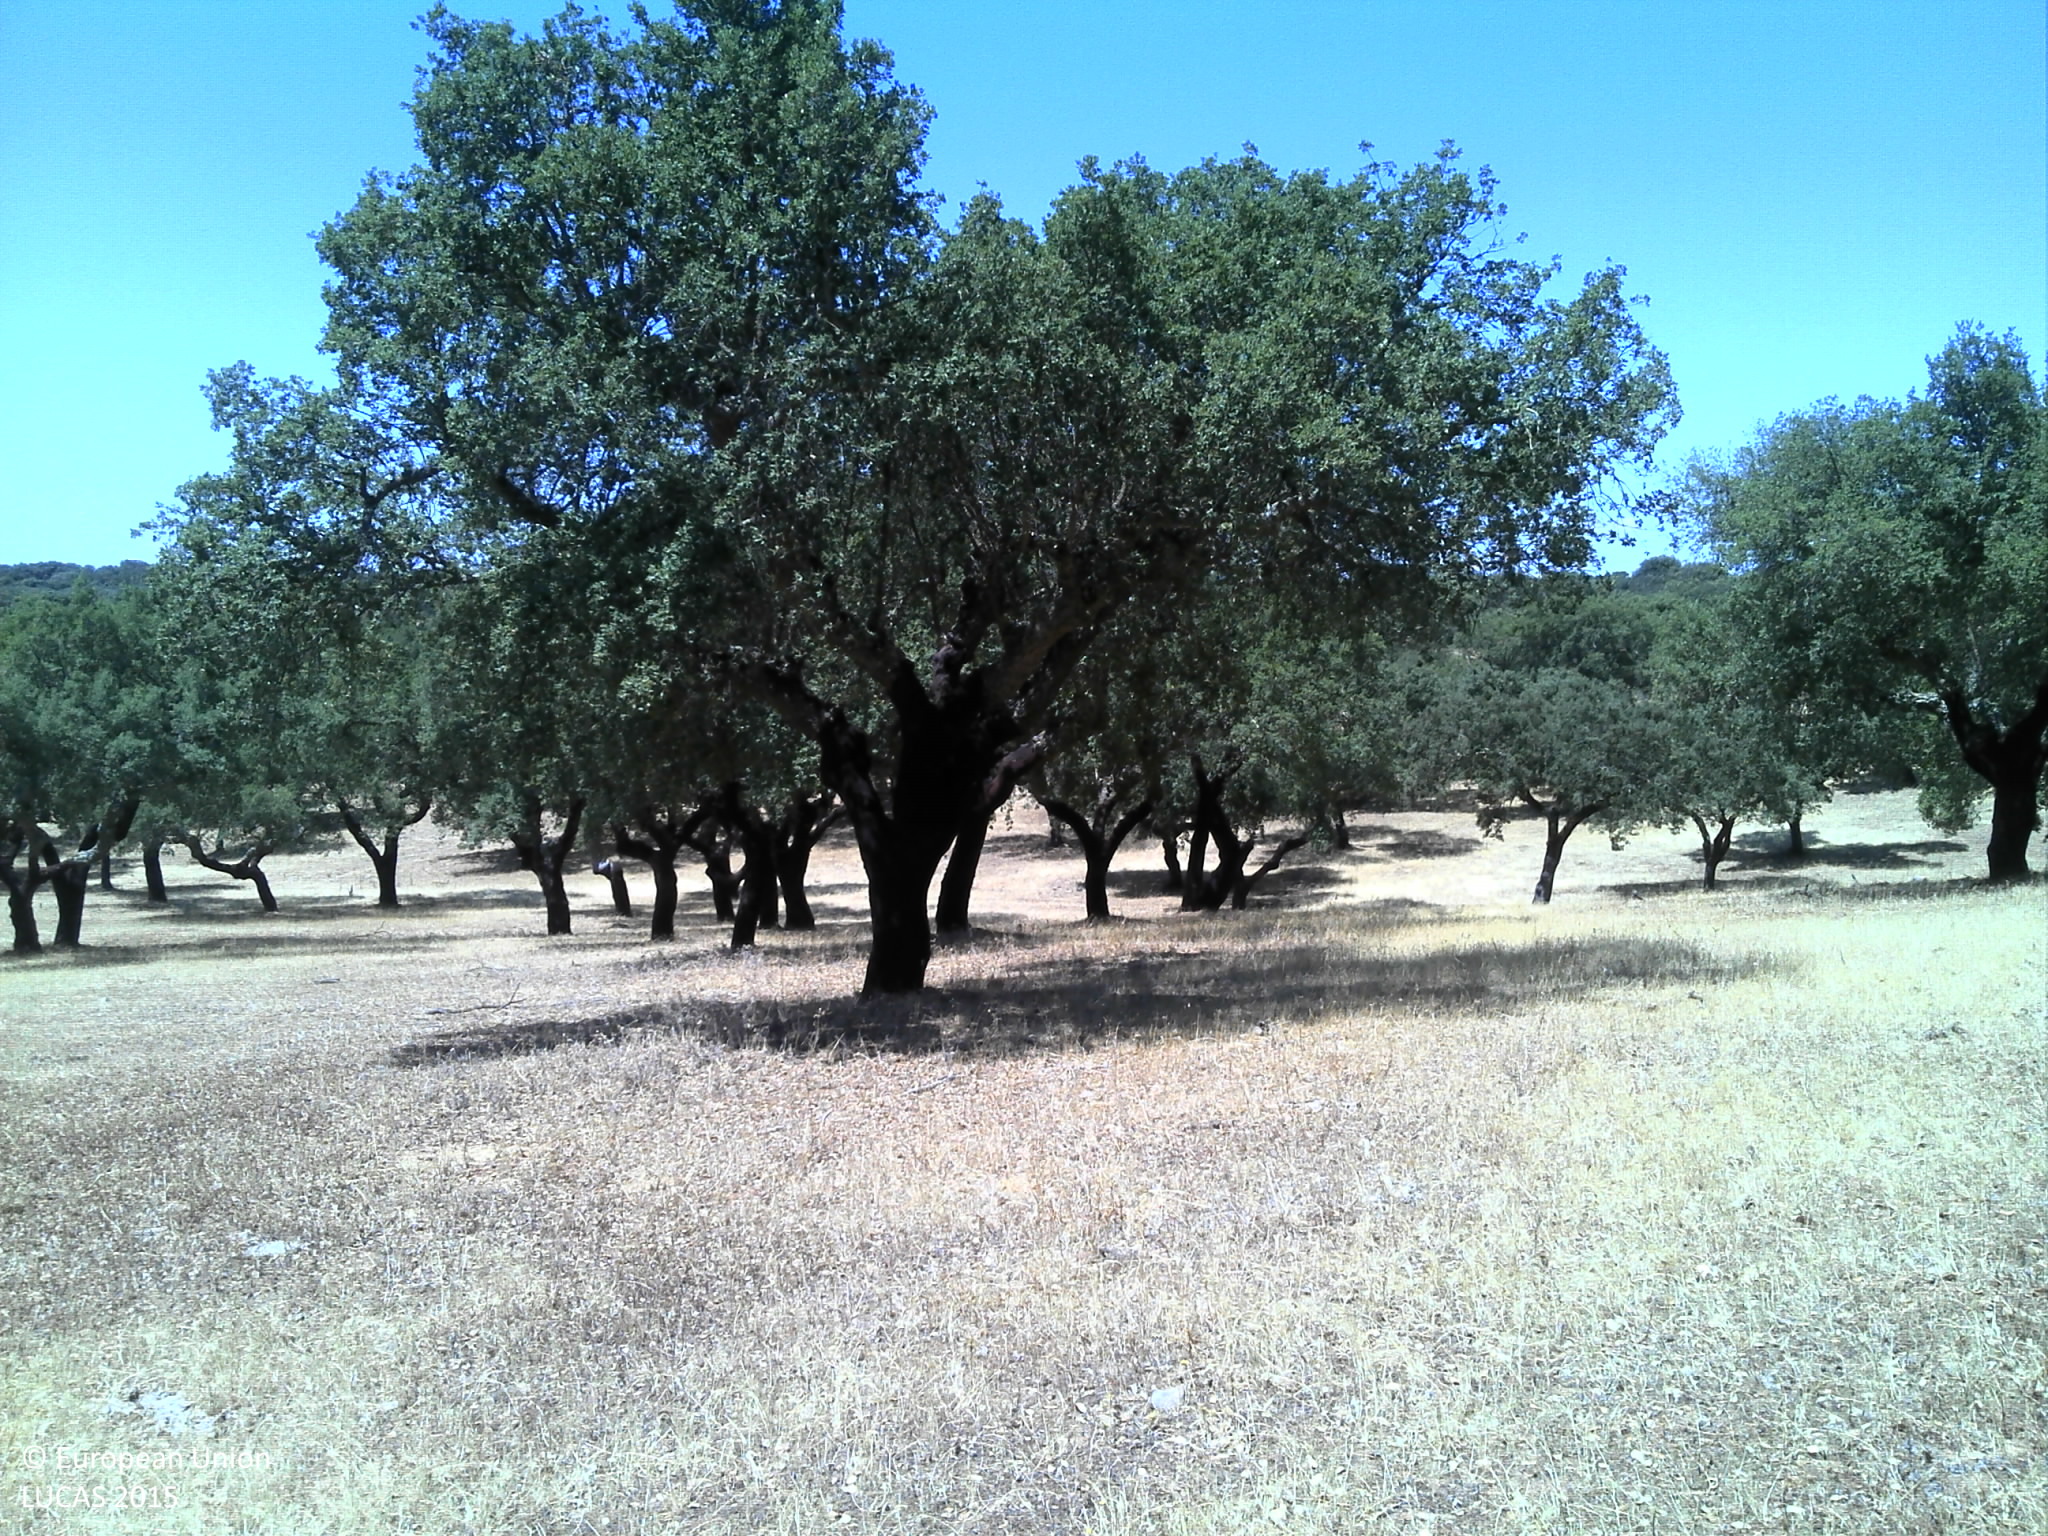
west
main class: Woodland
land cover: Broadleaved woodland
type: broadleaved evergreen forest
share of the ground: 50 - 75 %
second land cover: Grassland without tree/shrub cover
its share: 10 - 25 %
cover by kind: broadleaved forest trees 60 %, herbaceous plants 20 %, unconsolidated bare surface 20 %
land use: Forestry
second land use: Agriculture (excluding fallow land and kitchen gardens)
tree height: > 5 m
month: July
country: PT
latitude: 39.1536
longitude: -7.3365
